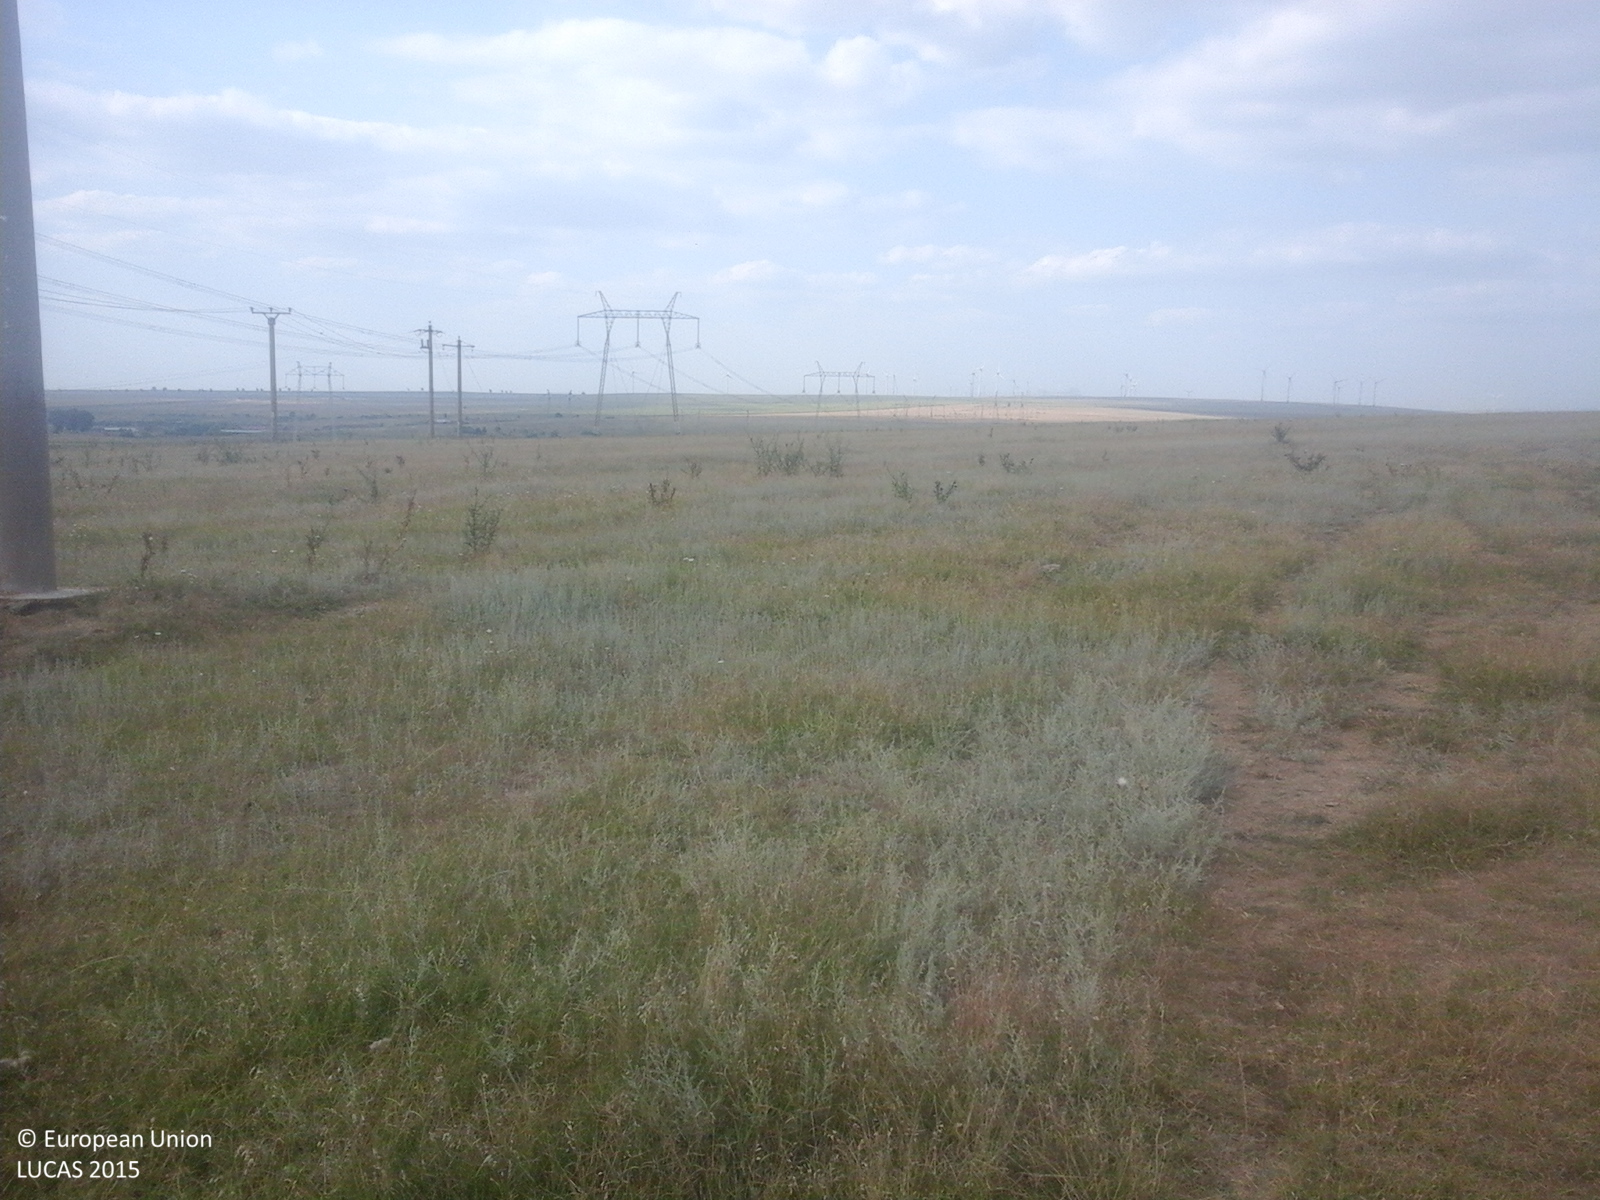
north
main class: Grassland
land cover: Grassland without tree/shrub cover
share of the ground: > 75 %
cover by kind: herbaceous plants 100 %
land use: Agriculture (excluding fallow land and kitchen gardens)
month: August
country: RO
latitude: 44.7117
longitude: 28.2307
